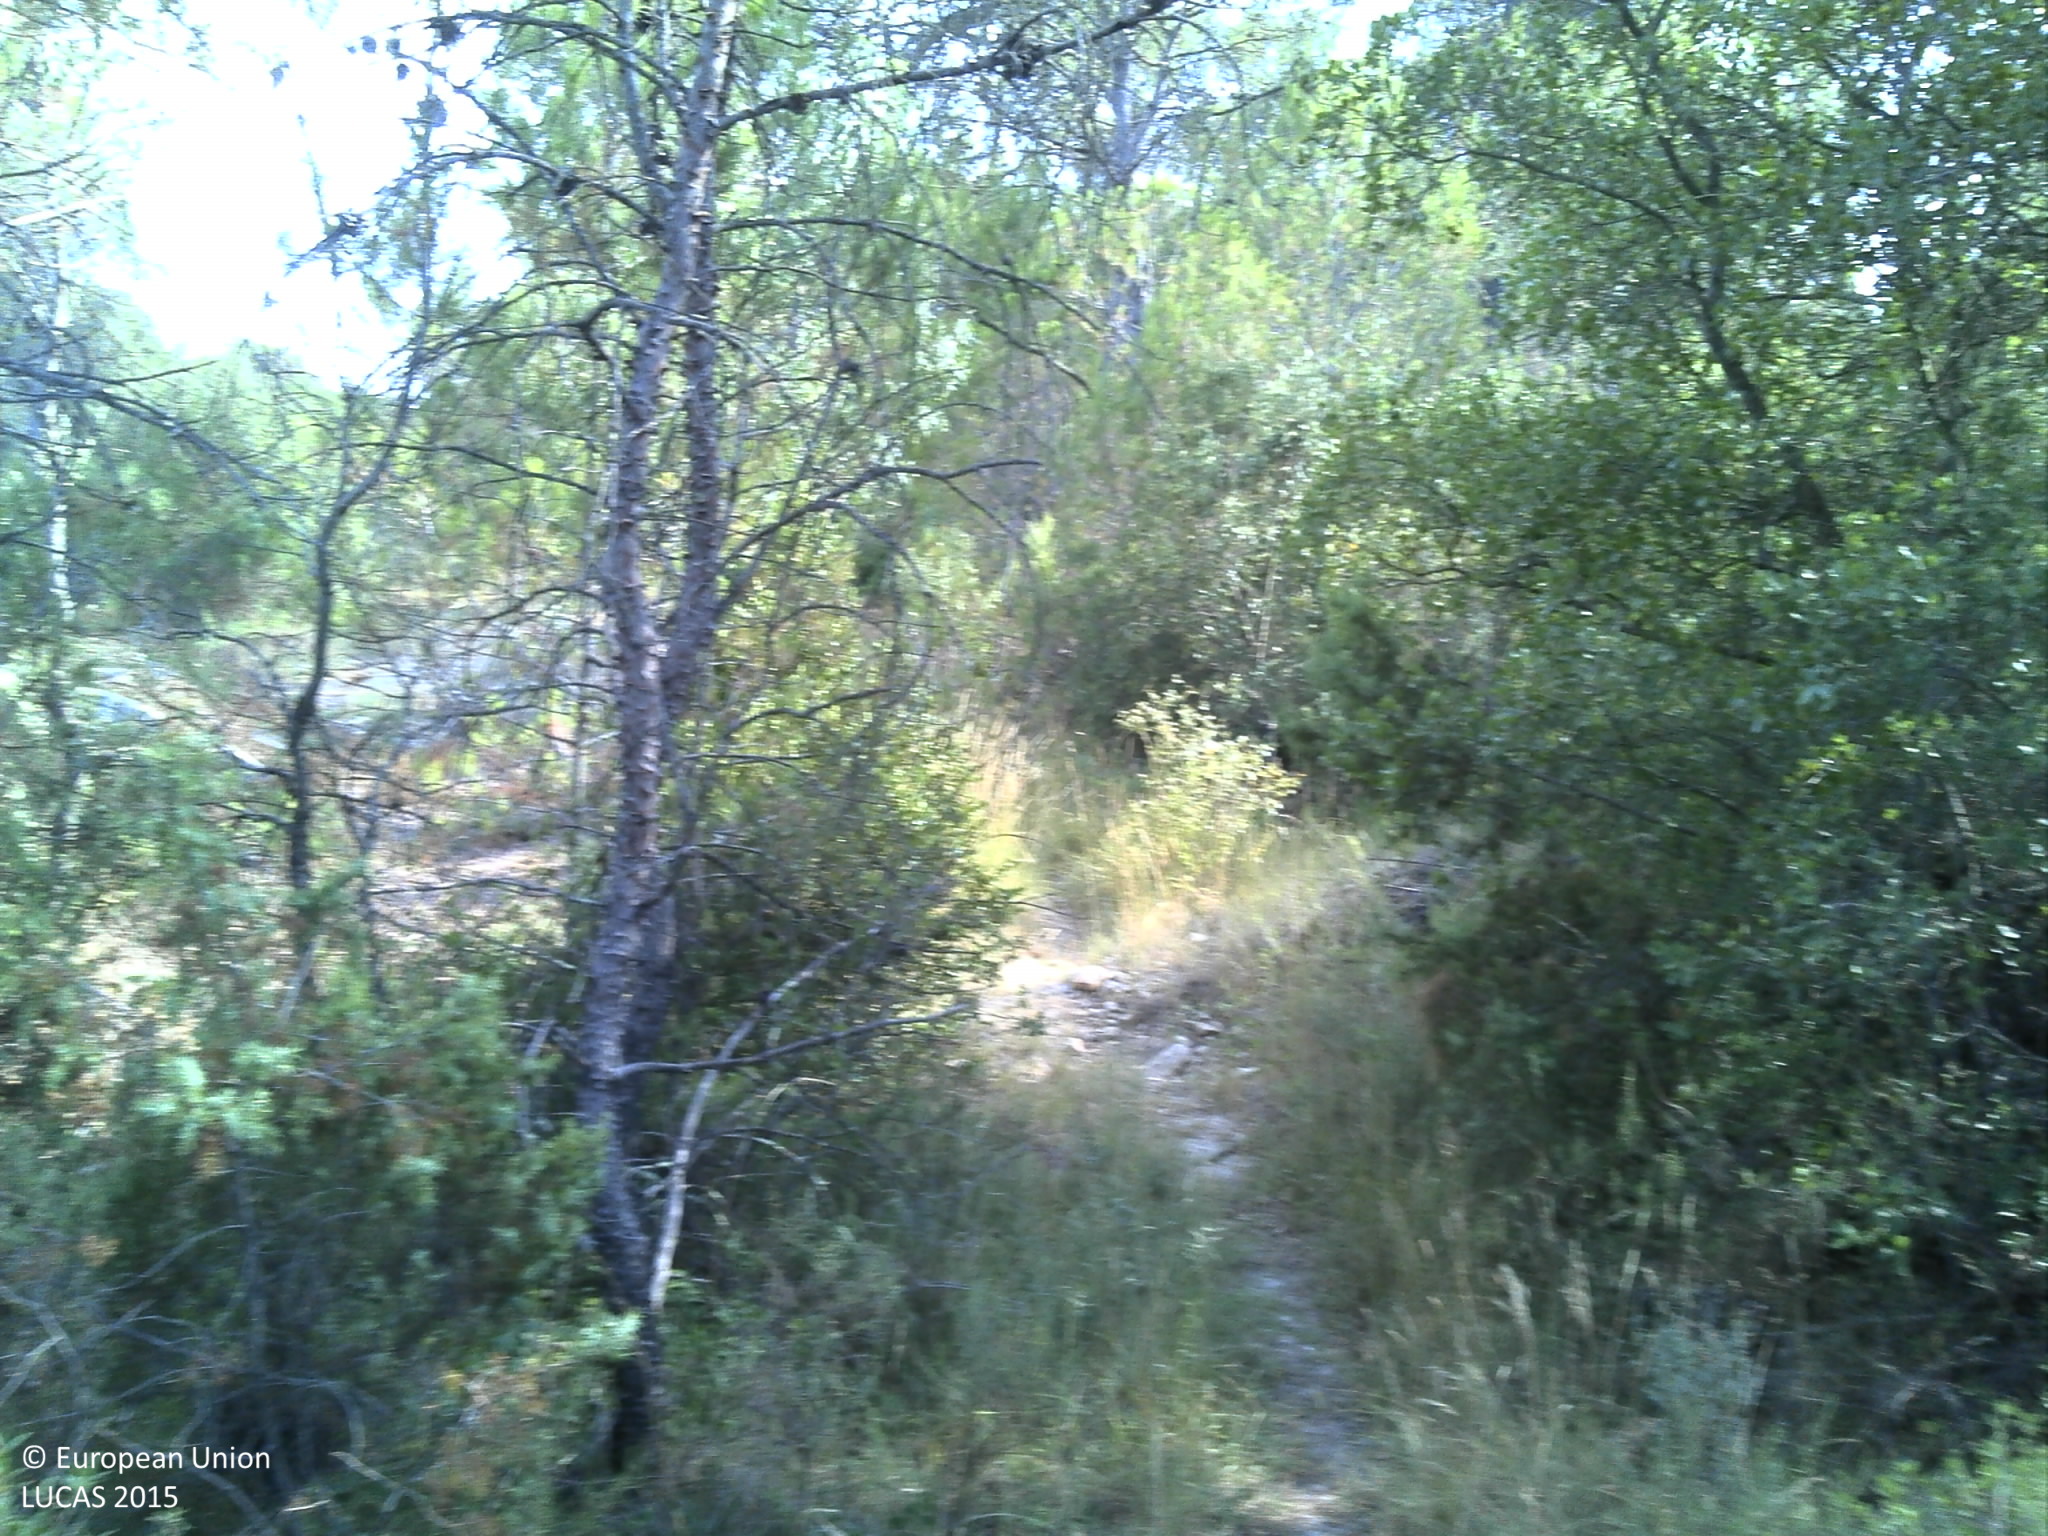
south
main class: Woodland
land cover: Pine dominated mixed woodland
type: coniferous forest of the mediterranean region
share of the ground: > 75 %
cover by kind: coniferous forest trees 50 %, broadleaved forest trees 25 %, herbaceous plants 15 %, unconsolidated bare surface 10 %
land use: Semi-natural and natural areas not in use
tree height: > 5 m
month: July
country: FR
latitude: 43.7780
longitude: 3.9827
